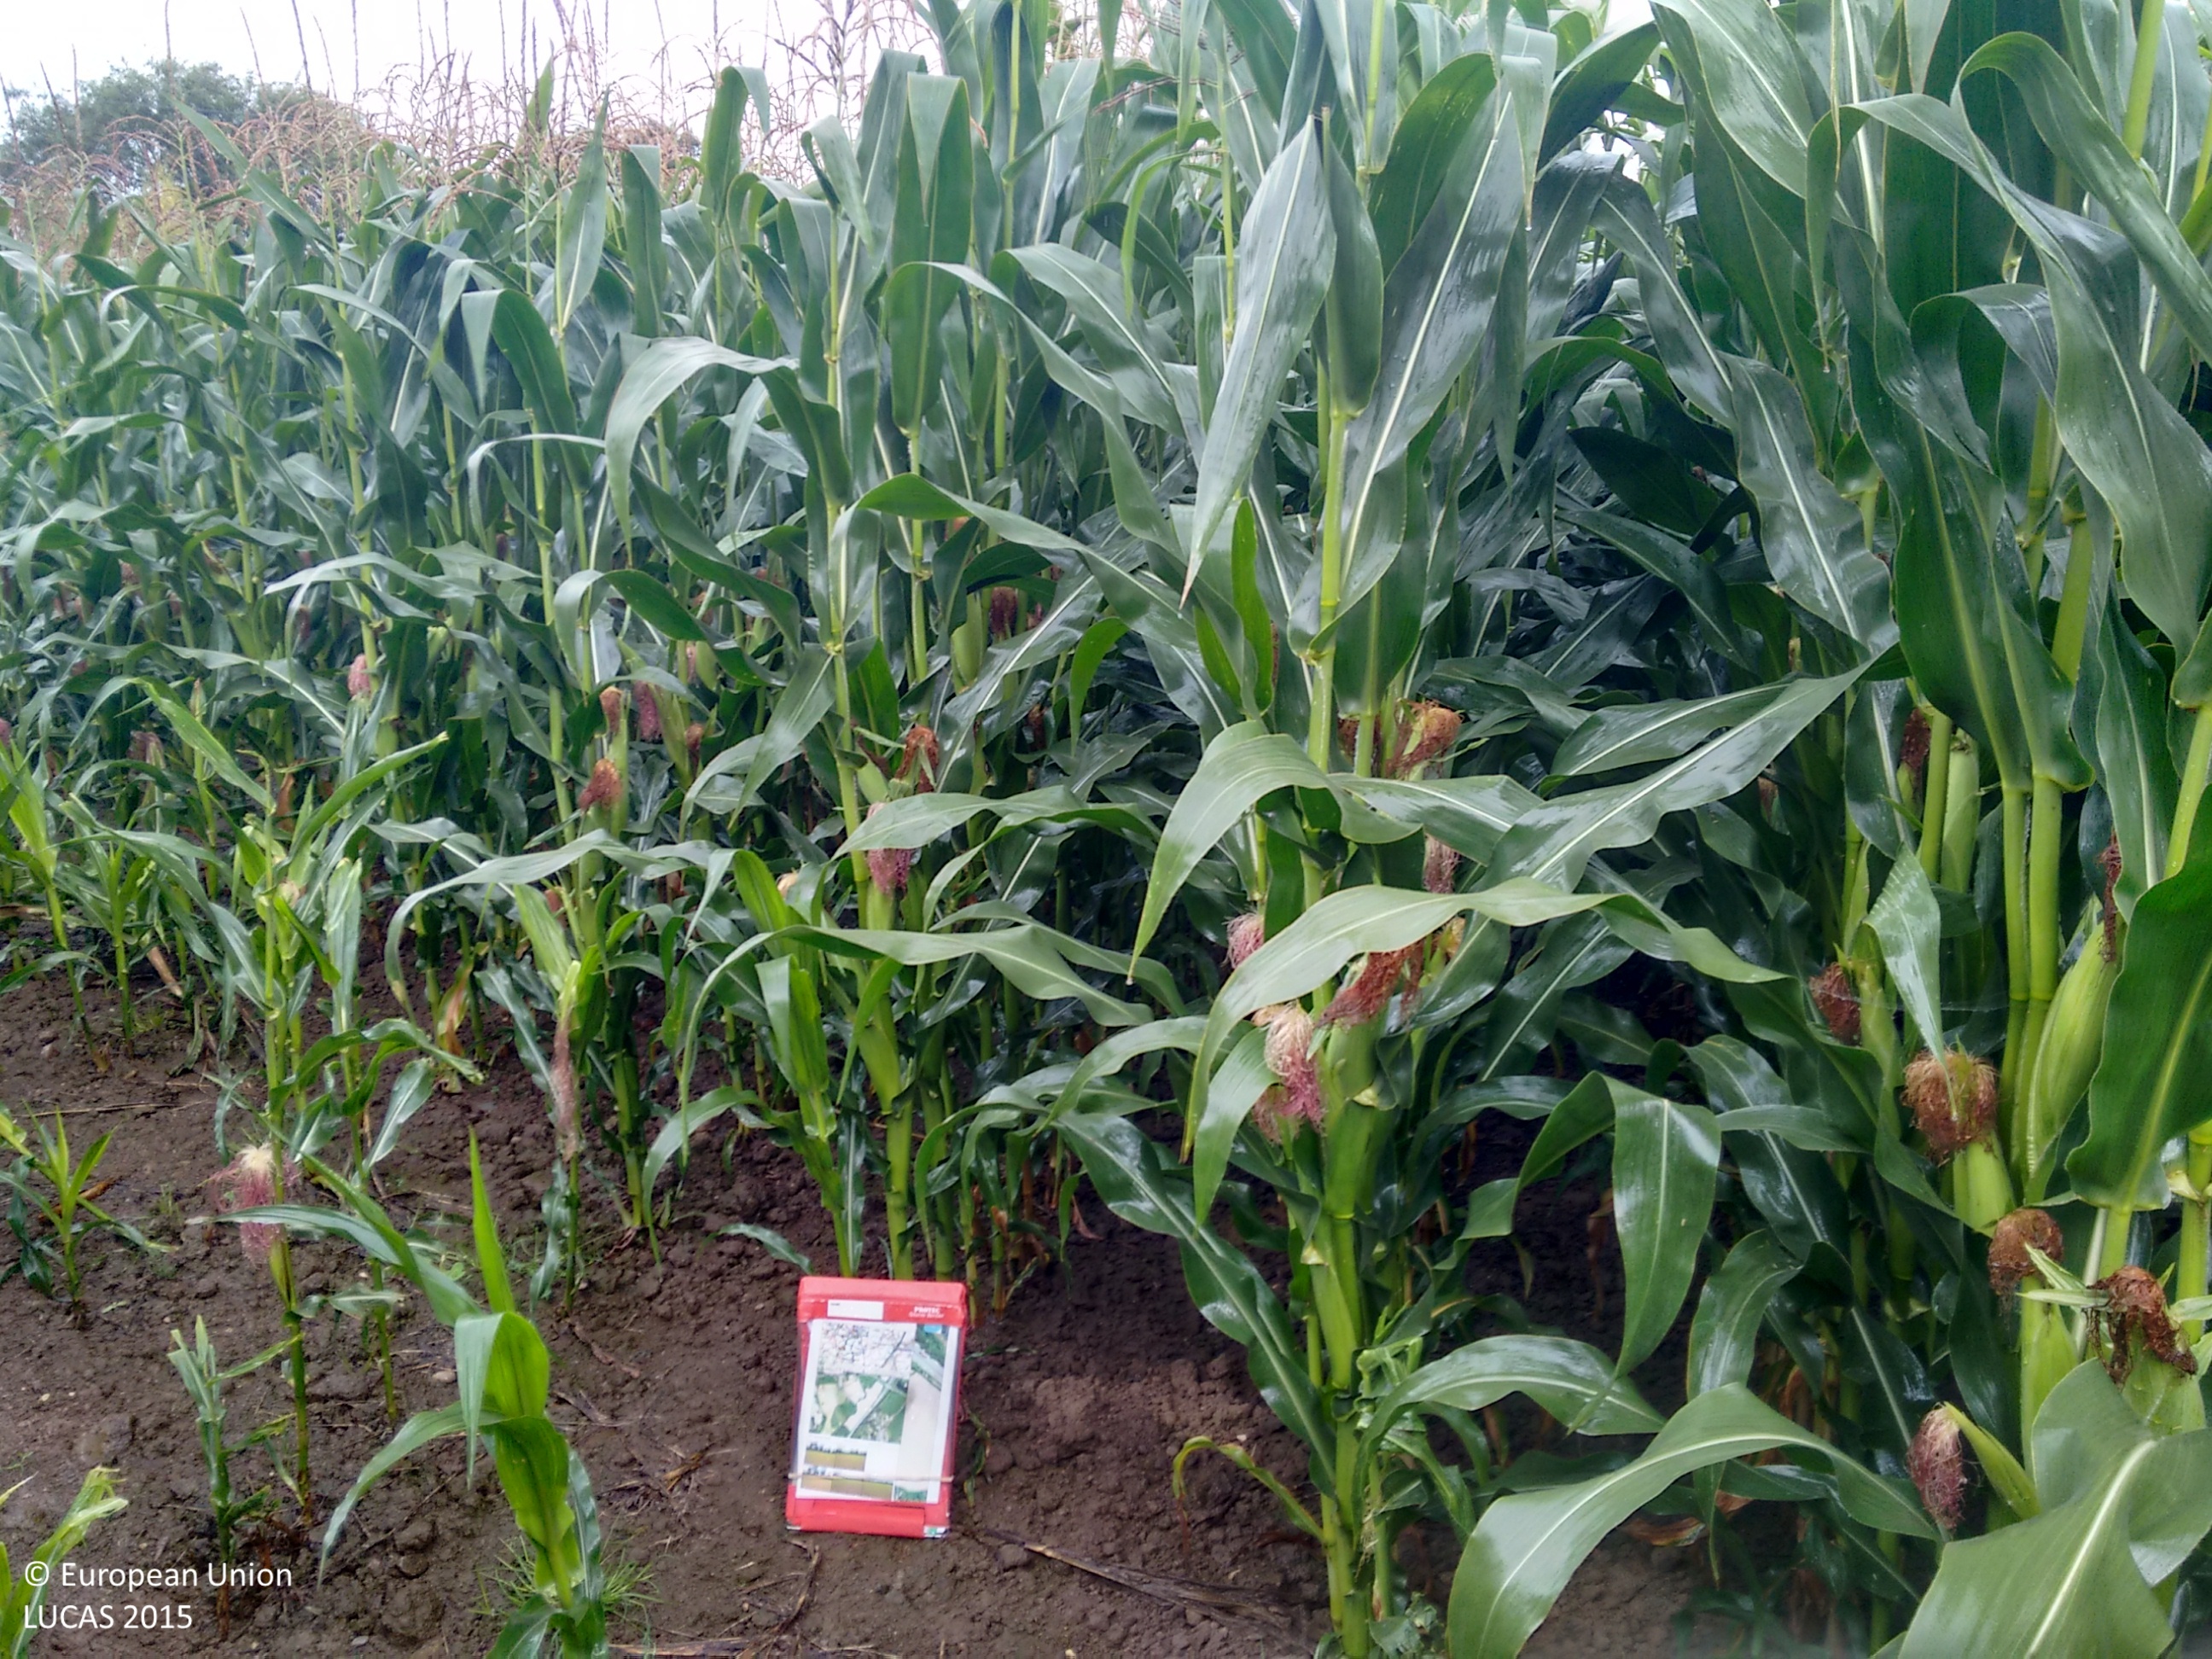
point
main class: Cropland
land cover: Maize
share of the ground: > 75 %
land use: Agriculture (excluding fallow land and kitchen gardens)
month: September
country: GB
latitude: 53.1022
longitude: -2.9636
